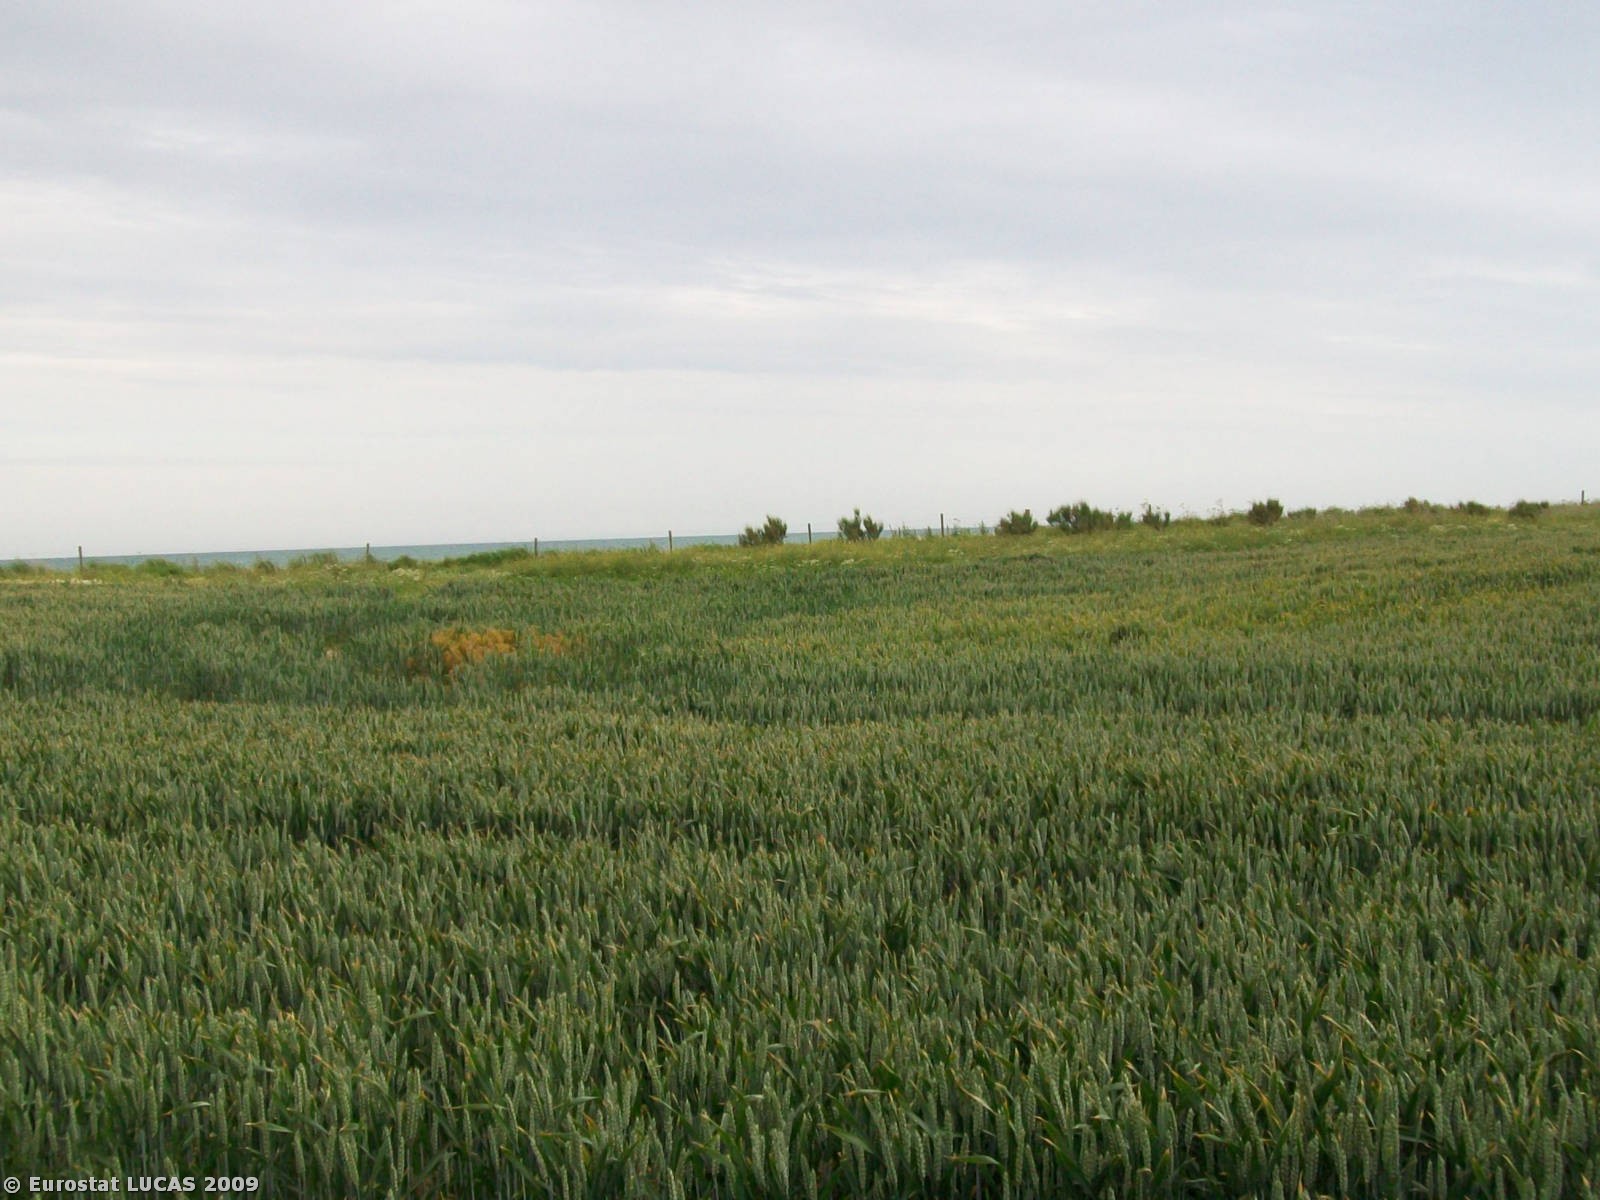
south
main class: Cropland
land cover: Common wheat
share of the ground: > 75 %
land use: Agriculture (excluding fallow land and kitchen gardens)
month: June
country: GB
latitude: 50.7969
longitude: -0.5806
